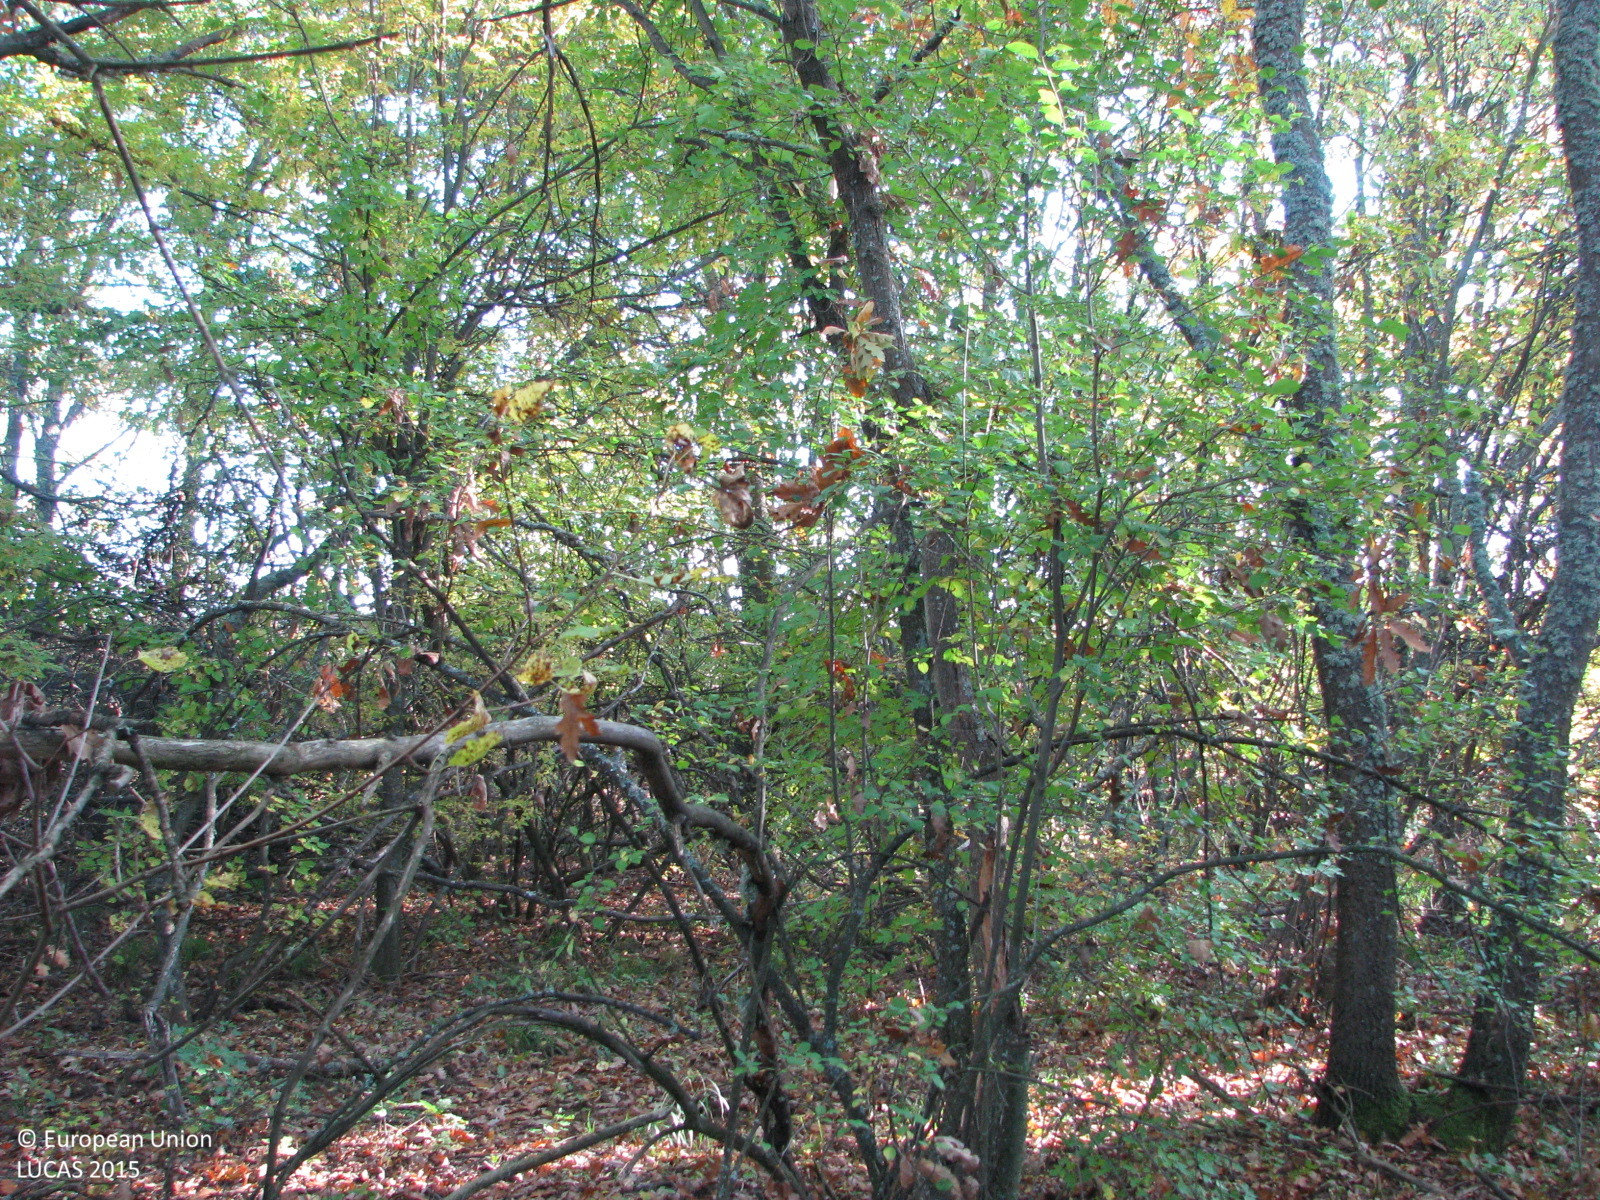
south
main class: Woodland
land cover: Broadleaved woodland
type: thermophilous deciduous forest
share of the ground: 50 - 75 %
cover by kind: broadleaved forest trees 70 %, unconsolidated bare surface 20 %, shrubs 10 %
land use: Forestry
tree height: > 5 m
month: October
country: BG
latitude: 42.3469
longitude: 26.8879
